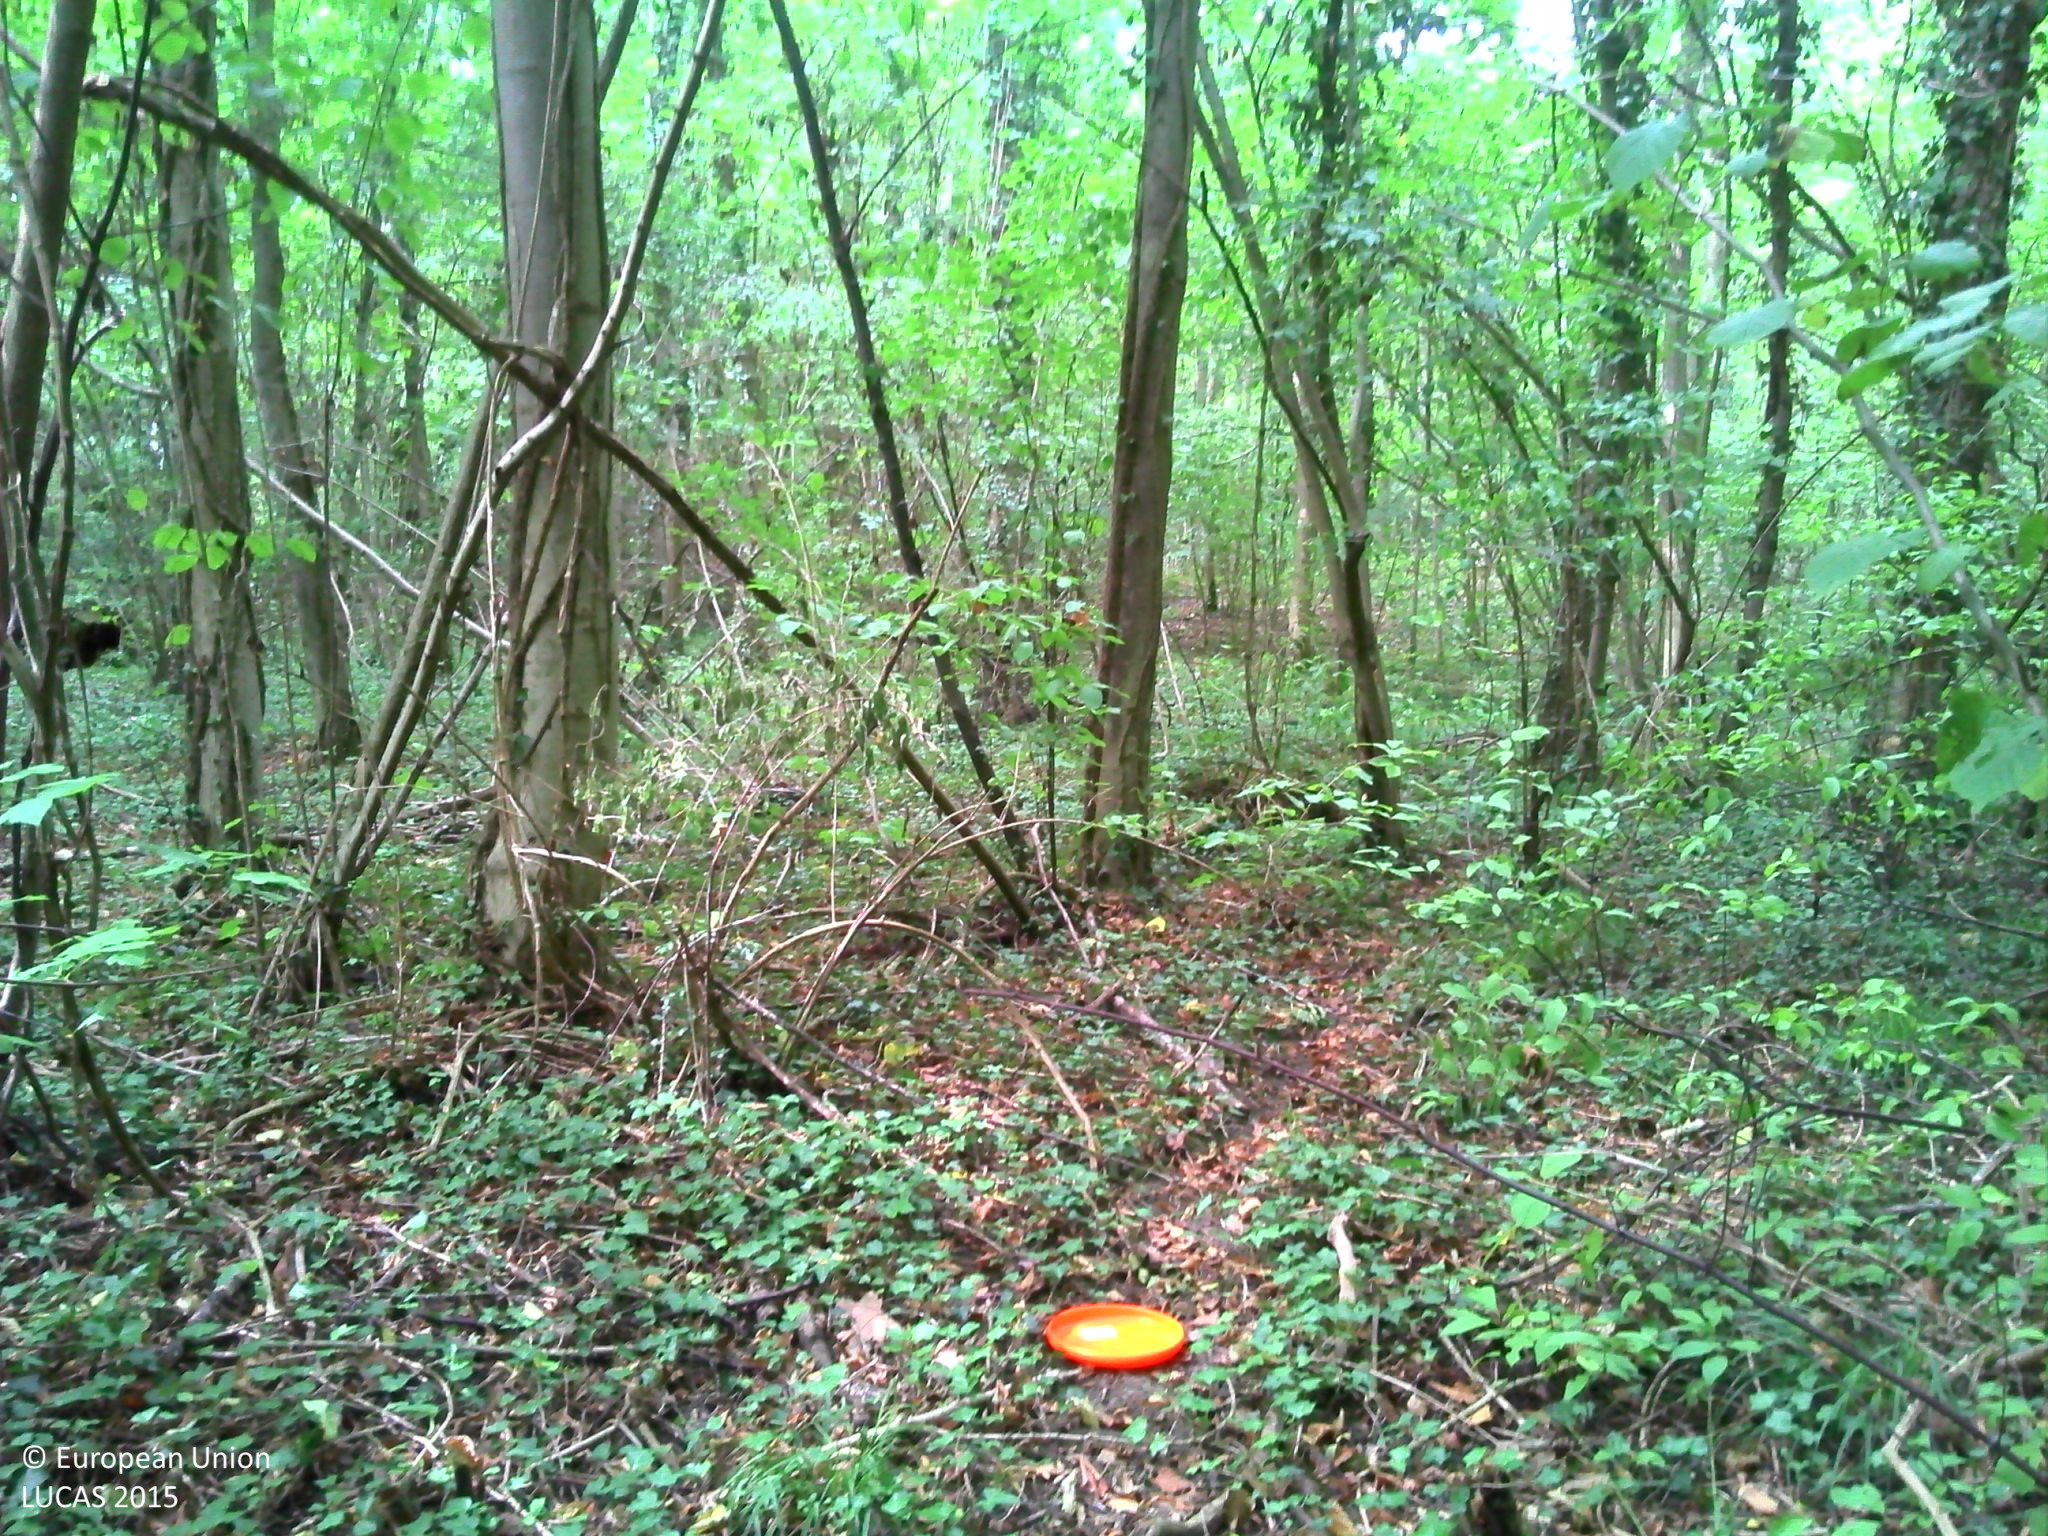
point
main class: Woodland
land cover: Broadleaved woodland
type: mesophytic deciduous forest
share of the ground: > 75 %
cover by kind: broadleaved forest trees 95 %, herbaceous plants 5 %
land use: Forestry
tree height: > 5 m
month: August
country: FR
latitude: 48.5064
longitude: 7.7404
